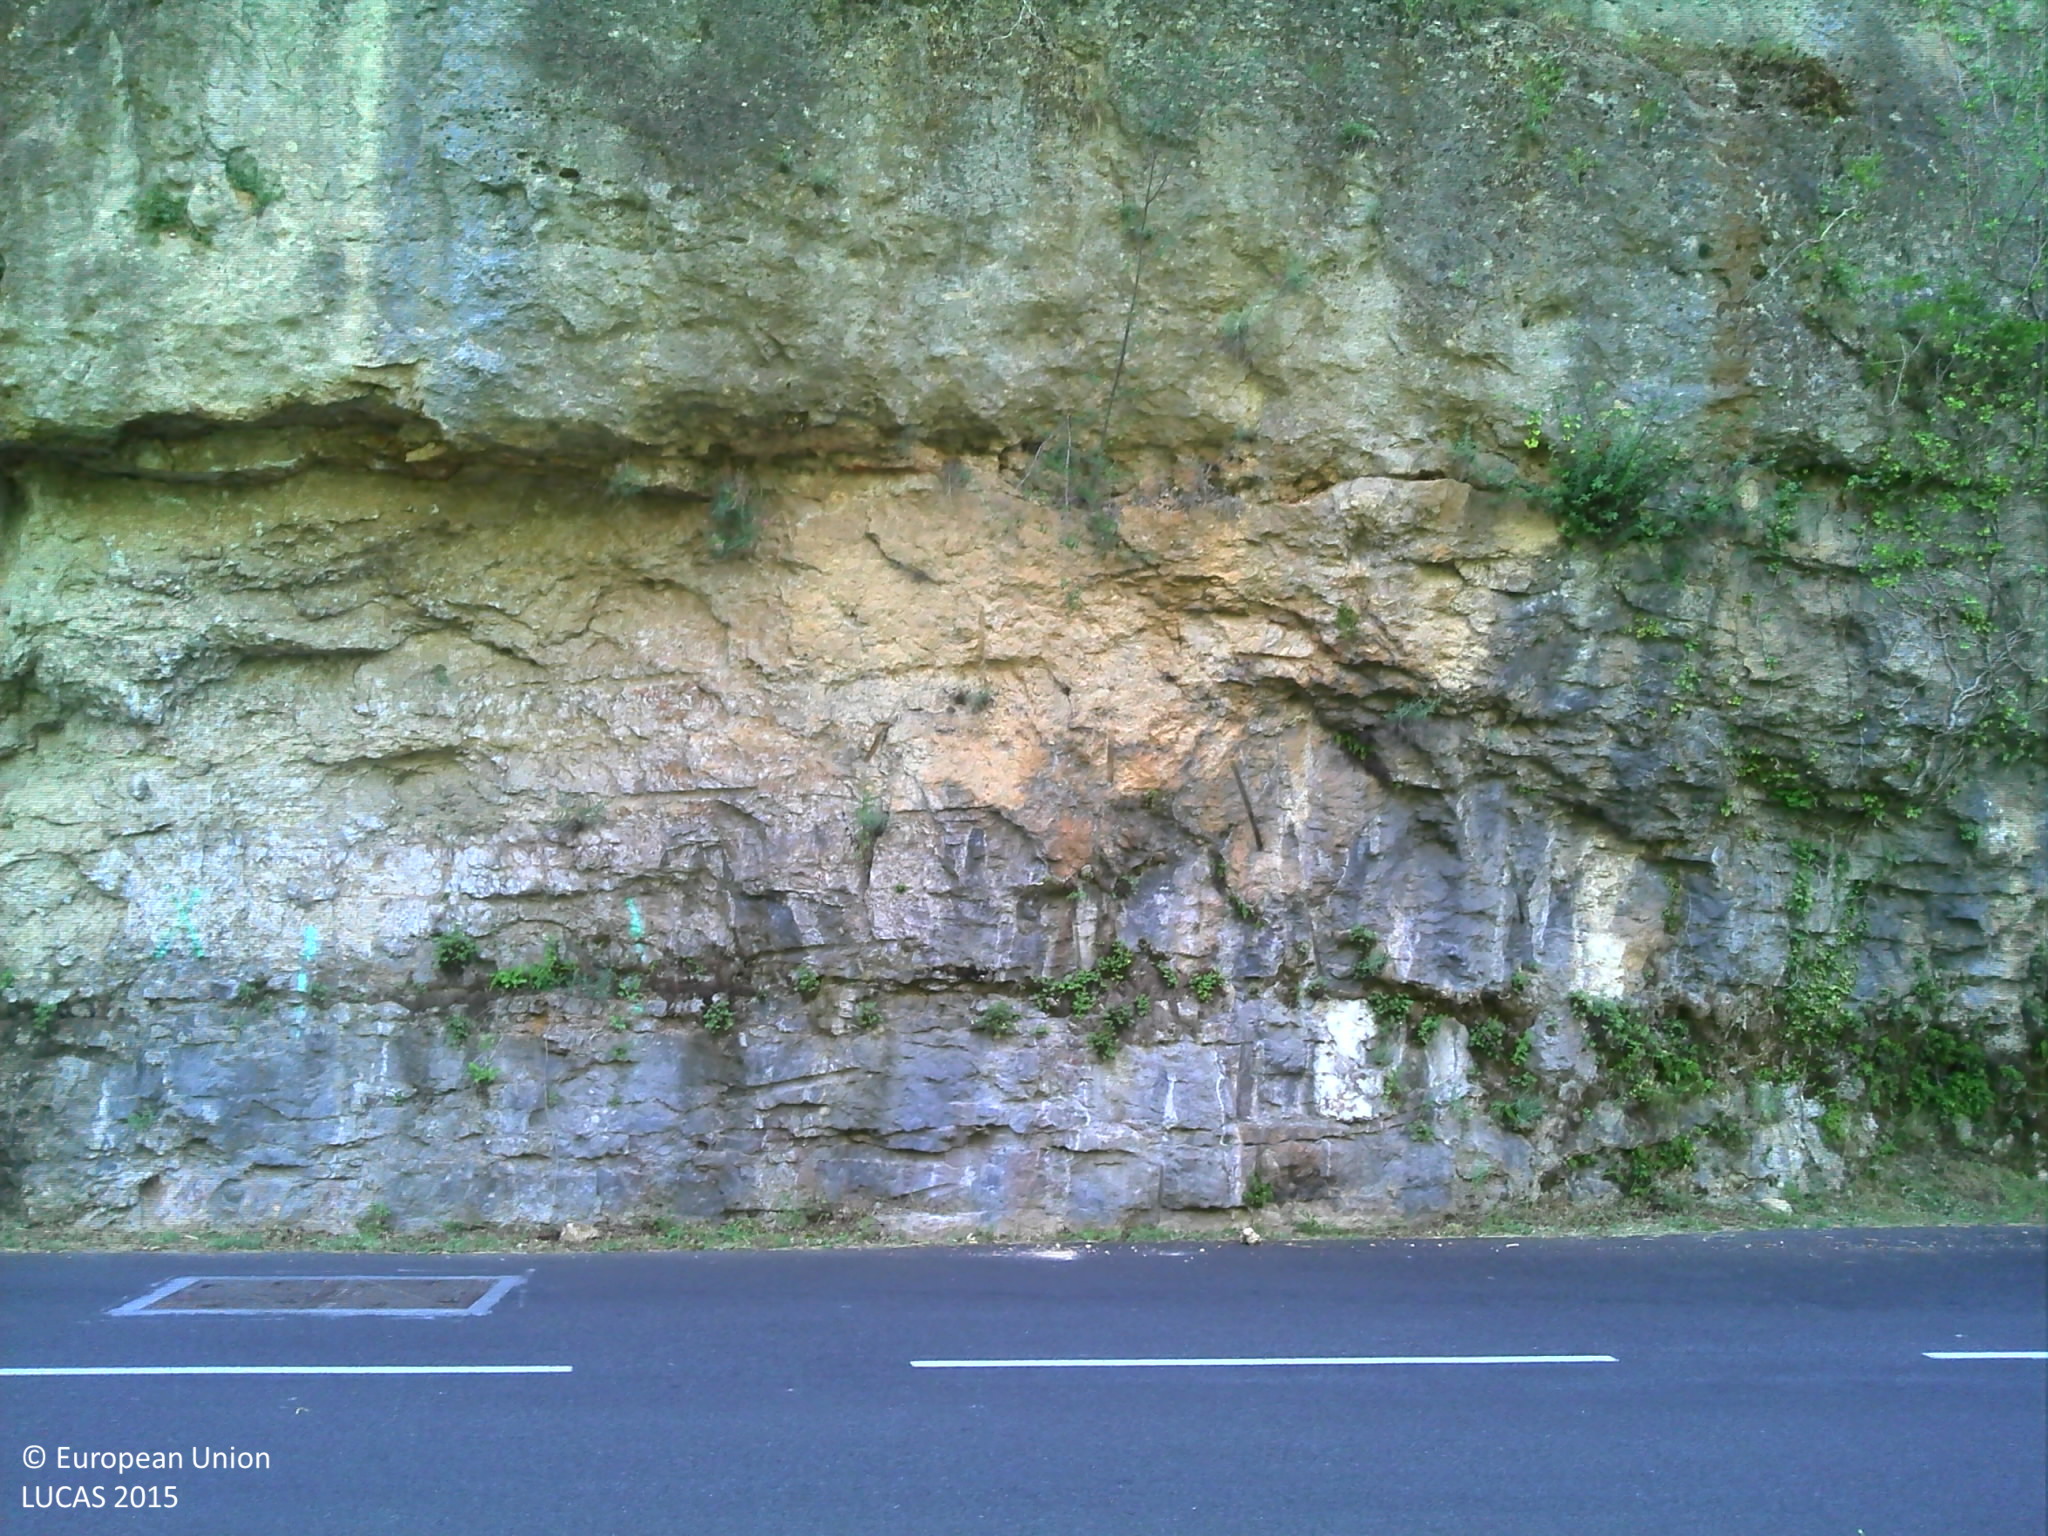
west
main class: Woodland
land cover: Pine dominated mixed woodland
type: hemiboreal forest and nemoral coniferous forest and mixed broadleaved-coniferous forest
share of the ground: > 75 %
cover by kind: broadleaved forest trees 75 %, coniferous forest trees 25 %
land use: Forestry
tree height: > 5 m
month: July
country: FR
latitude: 44.2381
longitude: 3.2318
